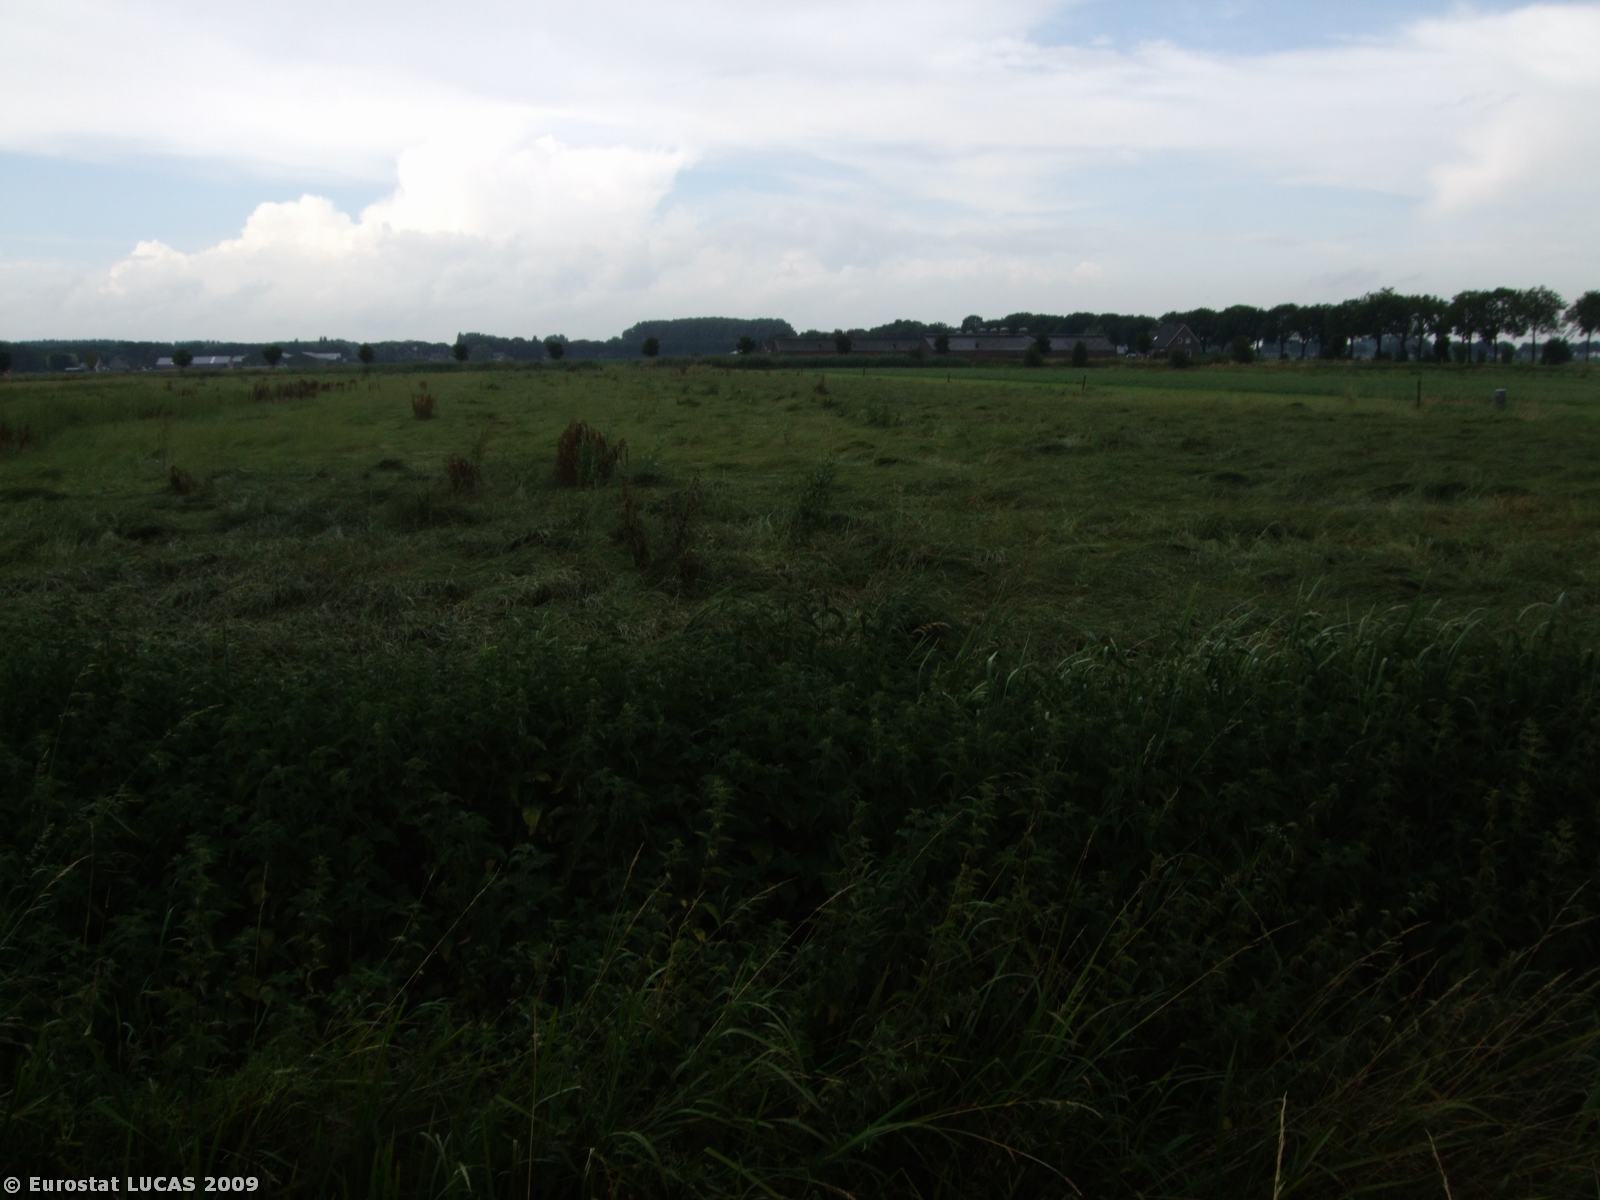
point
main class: Grassland
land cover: Grassland without tree/shrub cover
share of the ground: > 75 %
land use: Agriculture (excluding fallow land and kitchen gardens)
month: July
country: NL
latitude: 51.7844
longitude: 5.4028
